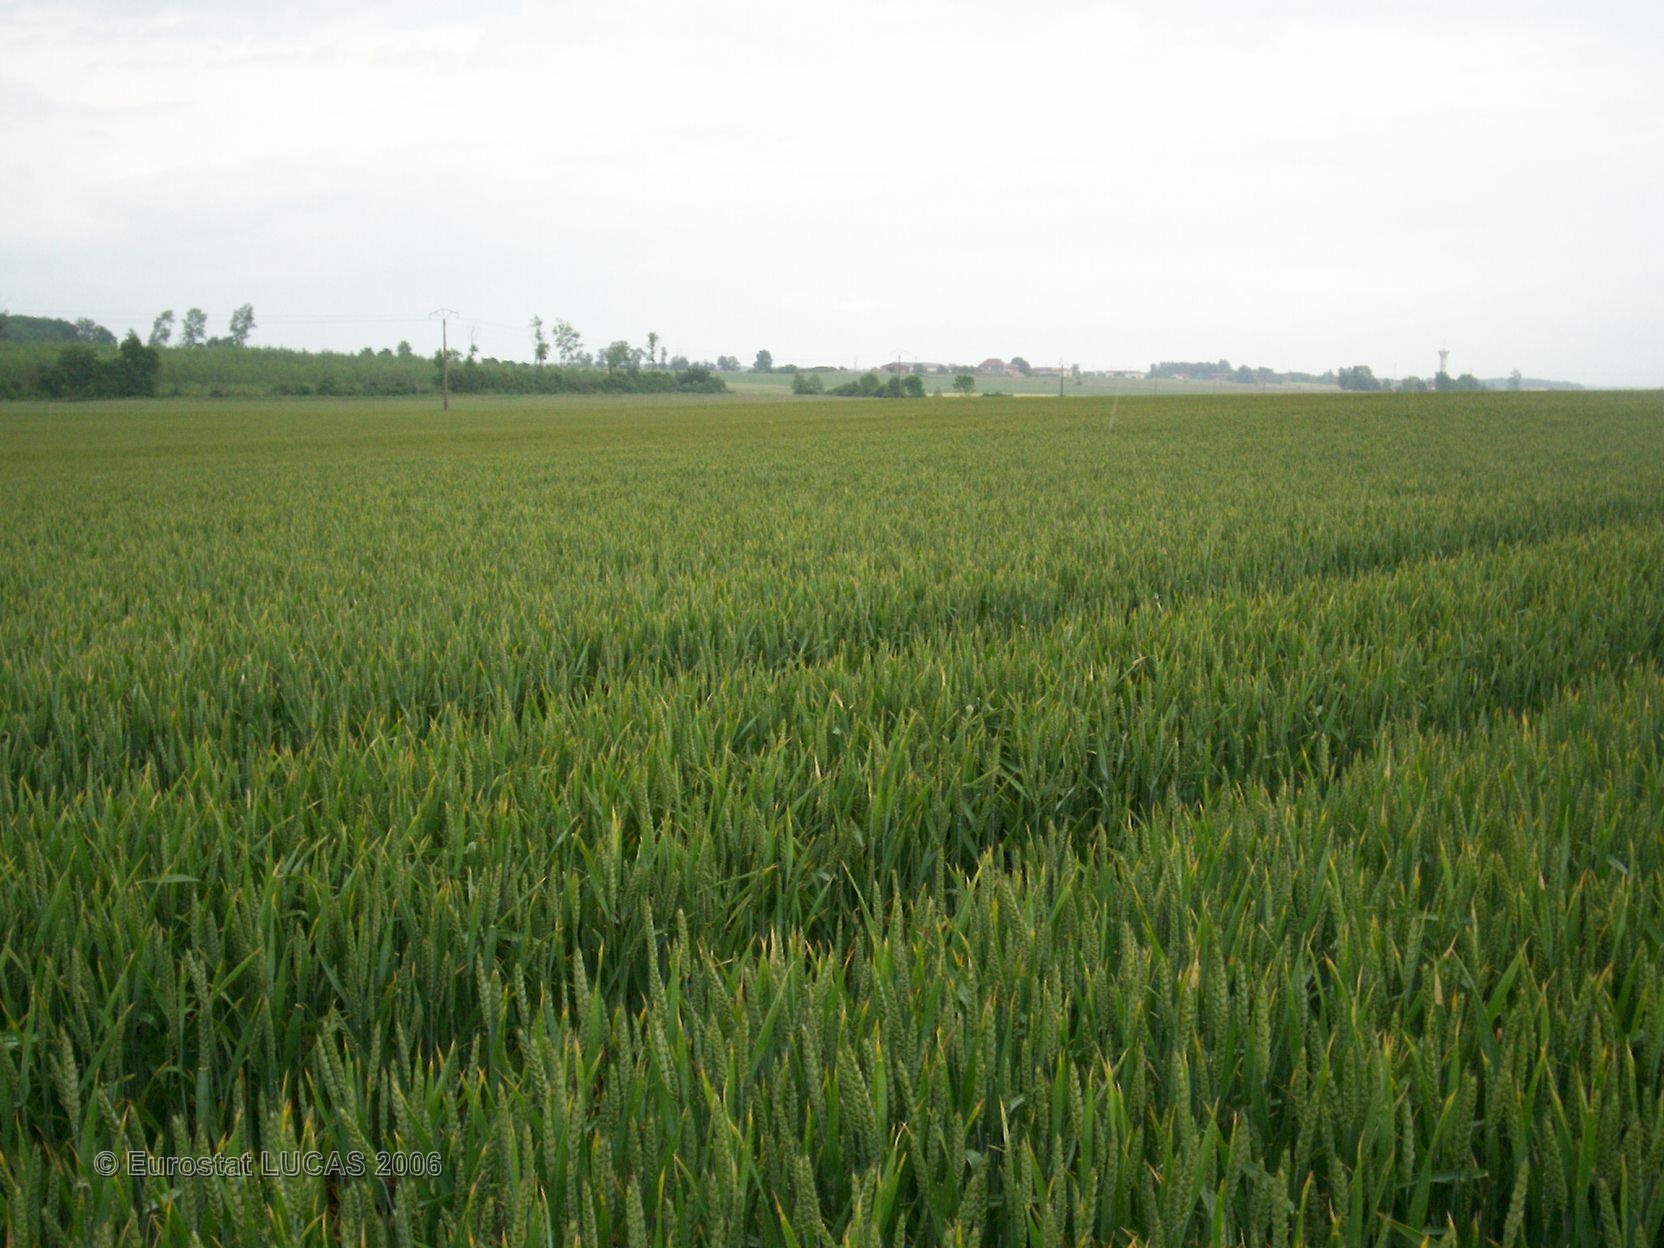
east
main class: Cropland
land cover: Common wheat
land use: Agriculture (excluding fallow land and kitchen gardens)
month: June
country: FR
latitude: 48.5623
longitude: 4.6451
